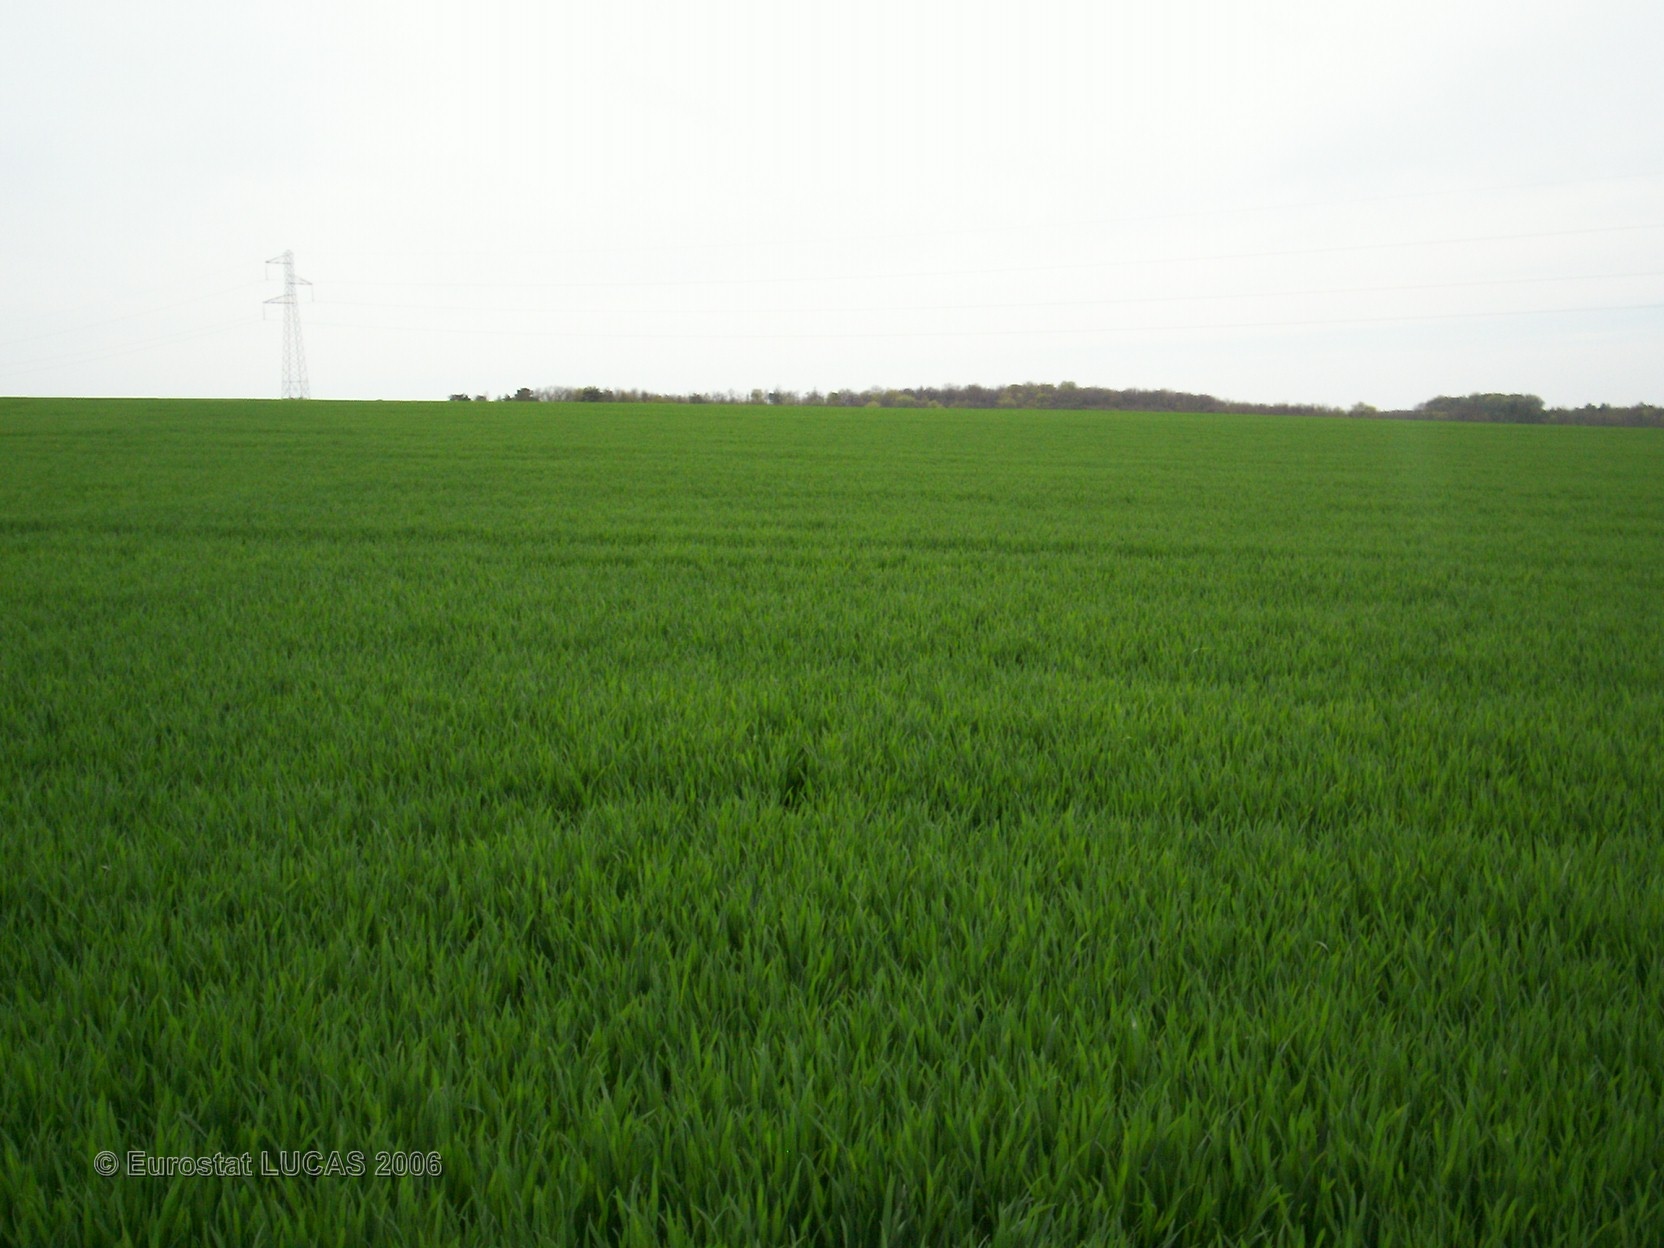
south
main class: Cropland
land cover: Common wheat
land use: Agriculture (excluding fallow land and kitchen gardens)
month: May
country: FR
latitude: 47.6368
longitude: 4.5286
